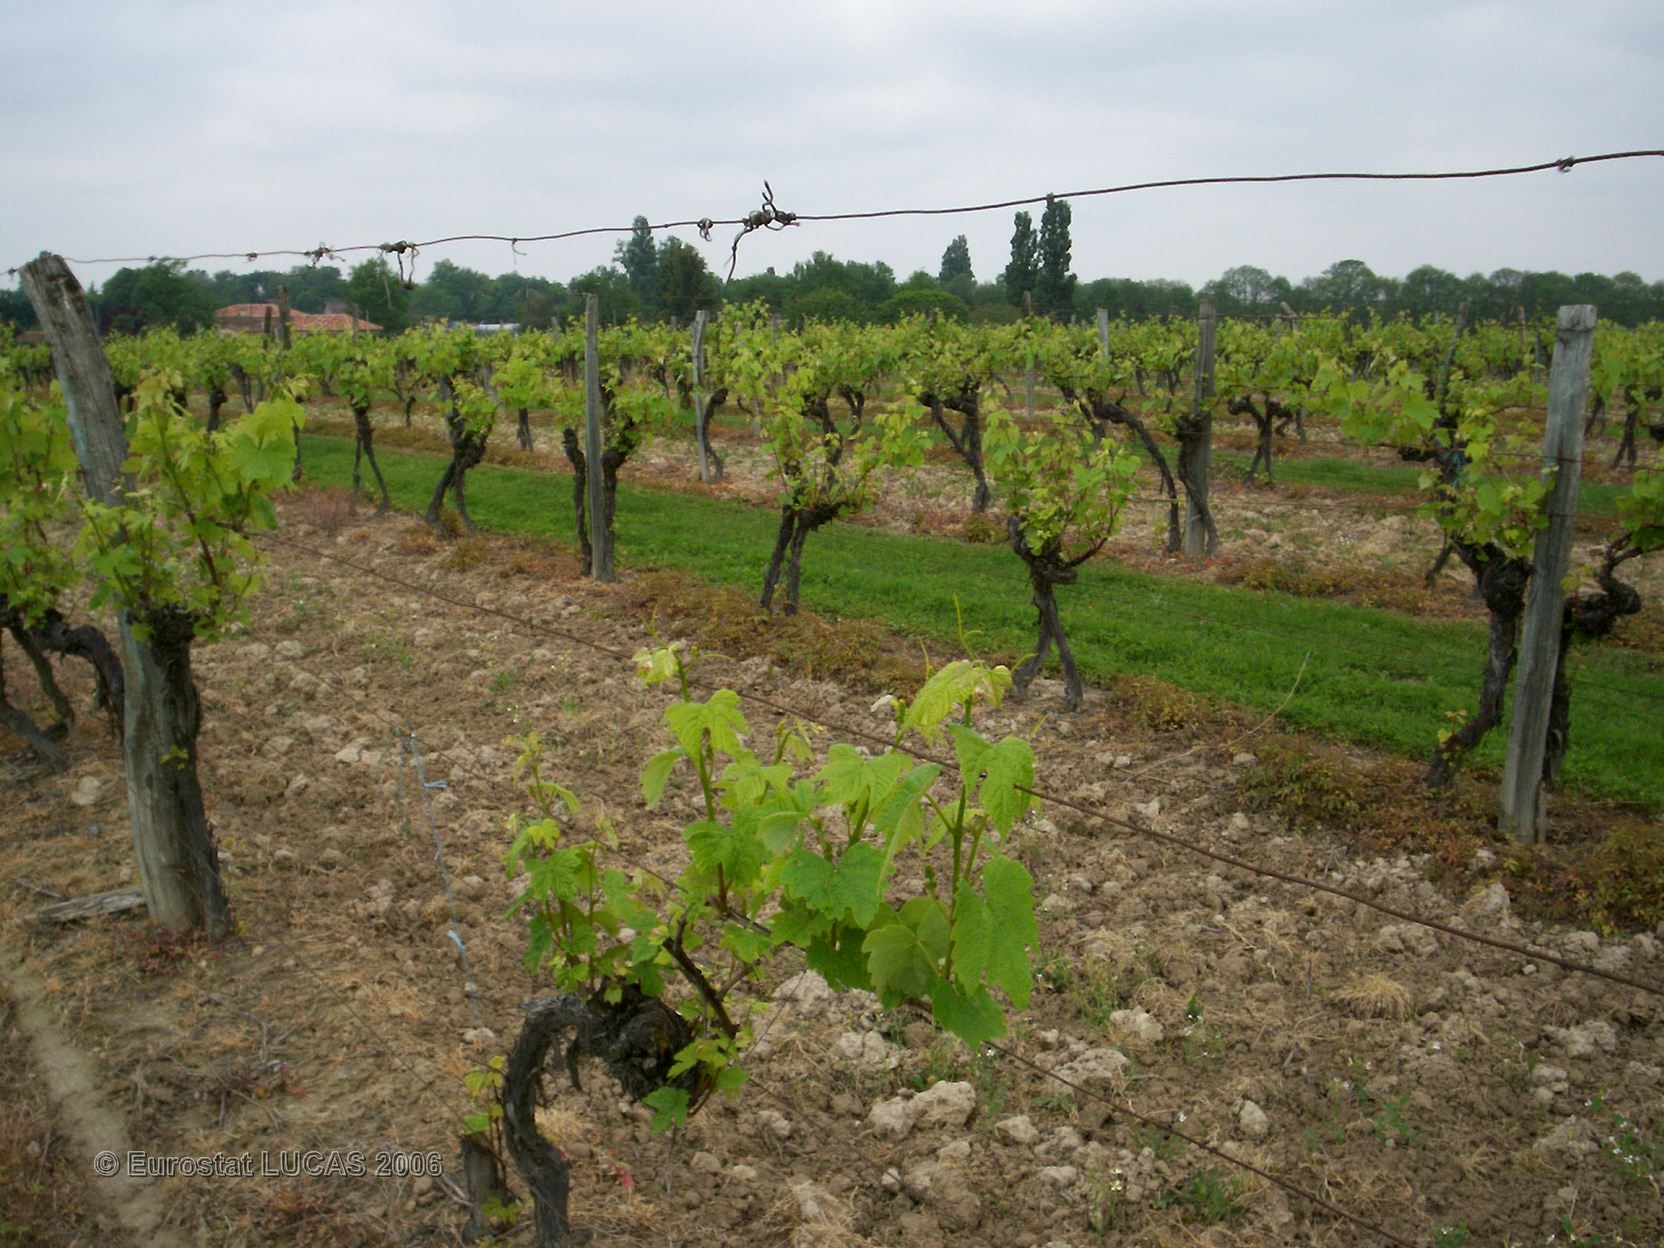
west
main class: Cropland
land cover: Vineyards
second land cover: Bare land
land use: Agriculture (excluding fallow land and kitchen gardens)
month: May
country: FR
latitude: 43.8450
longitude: 0.1547
